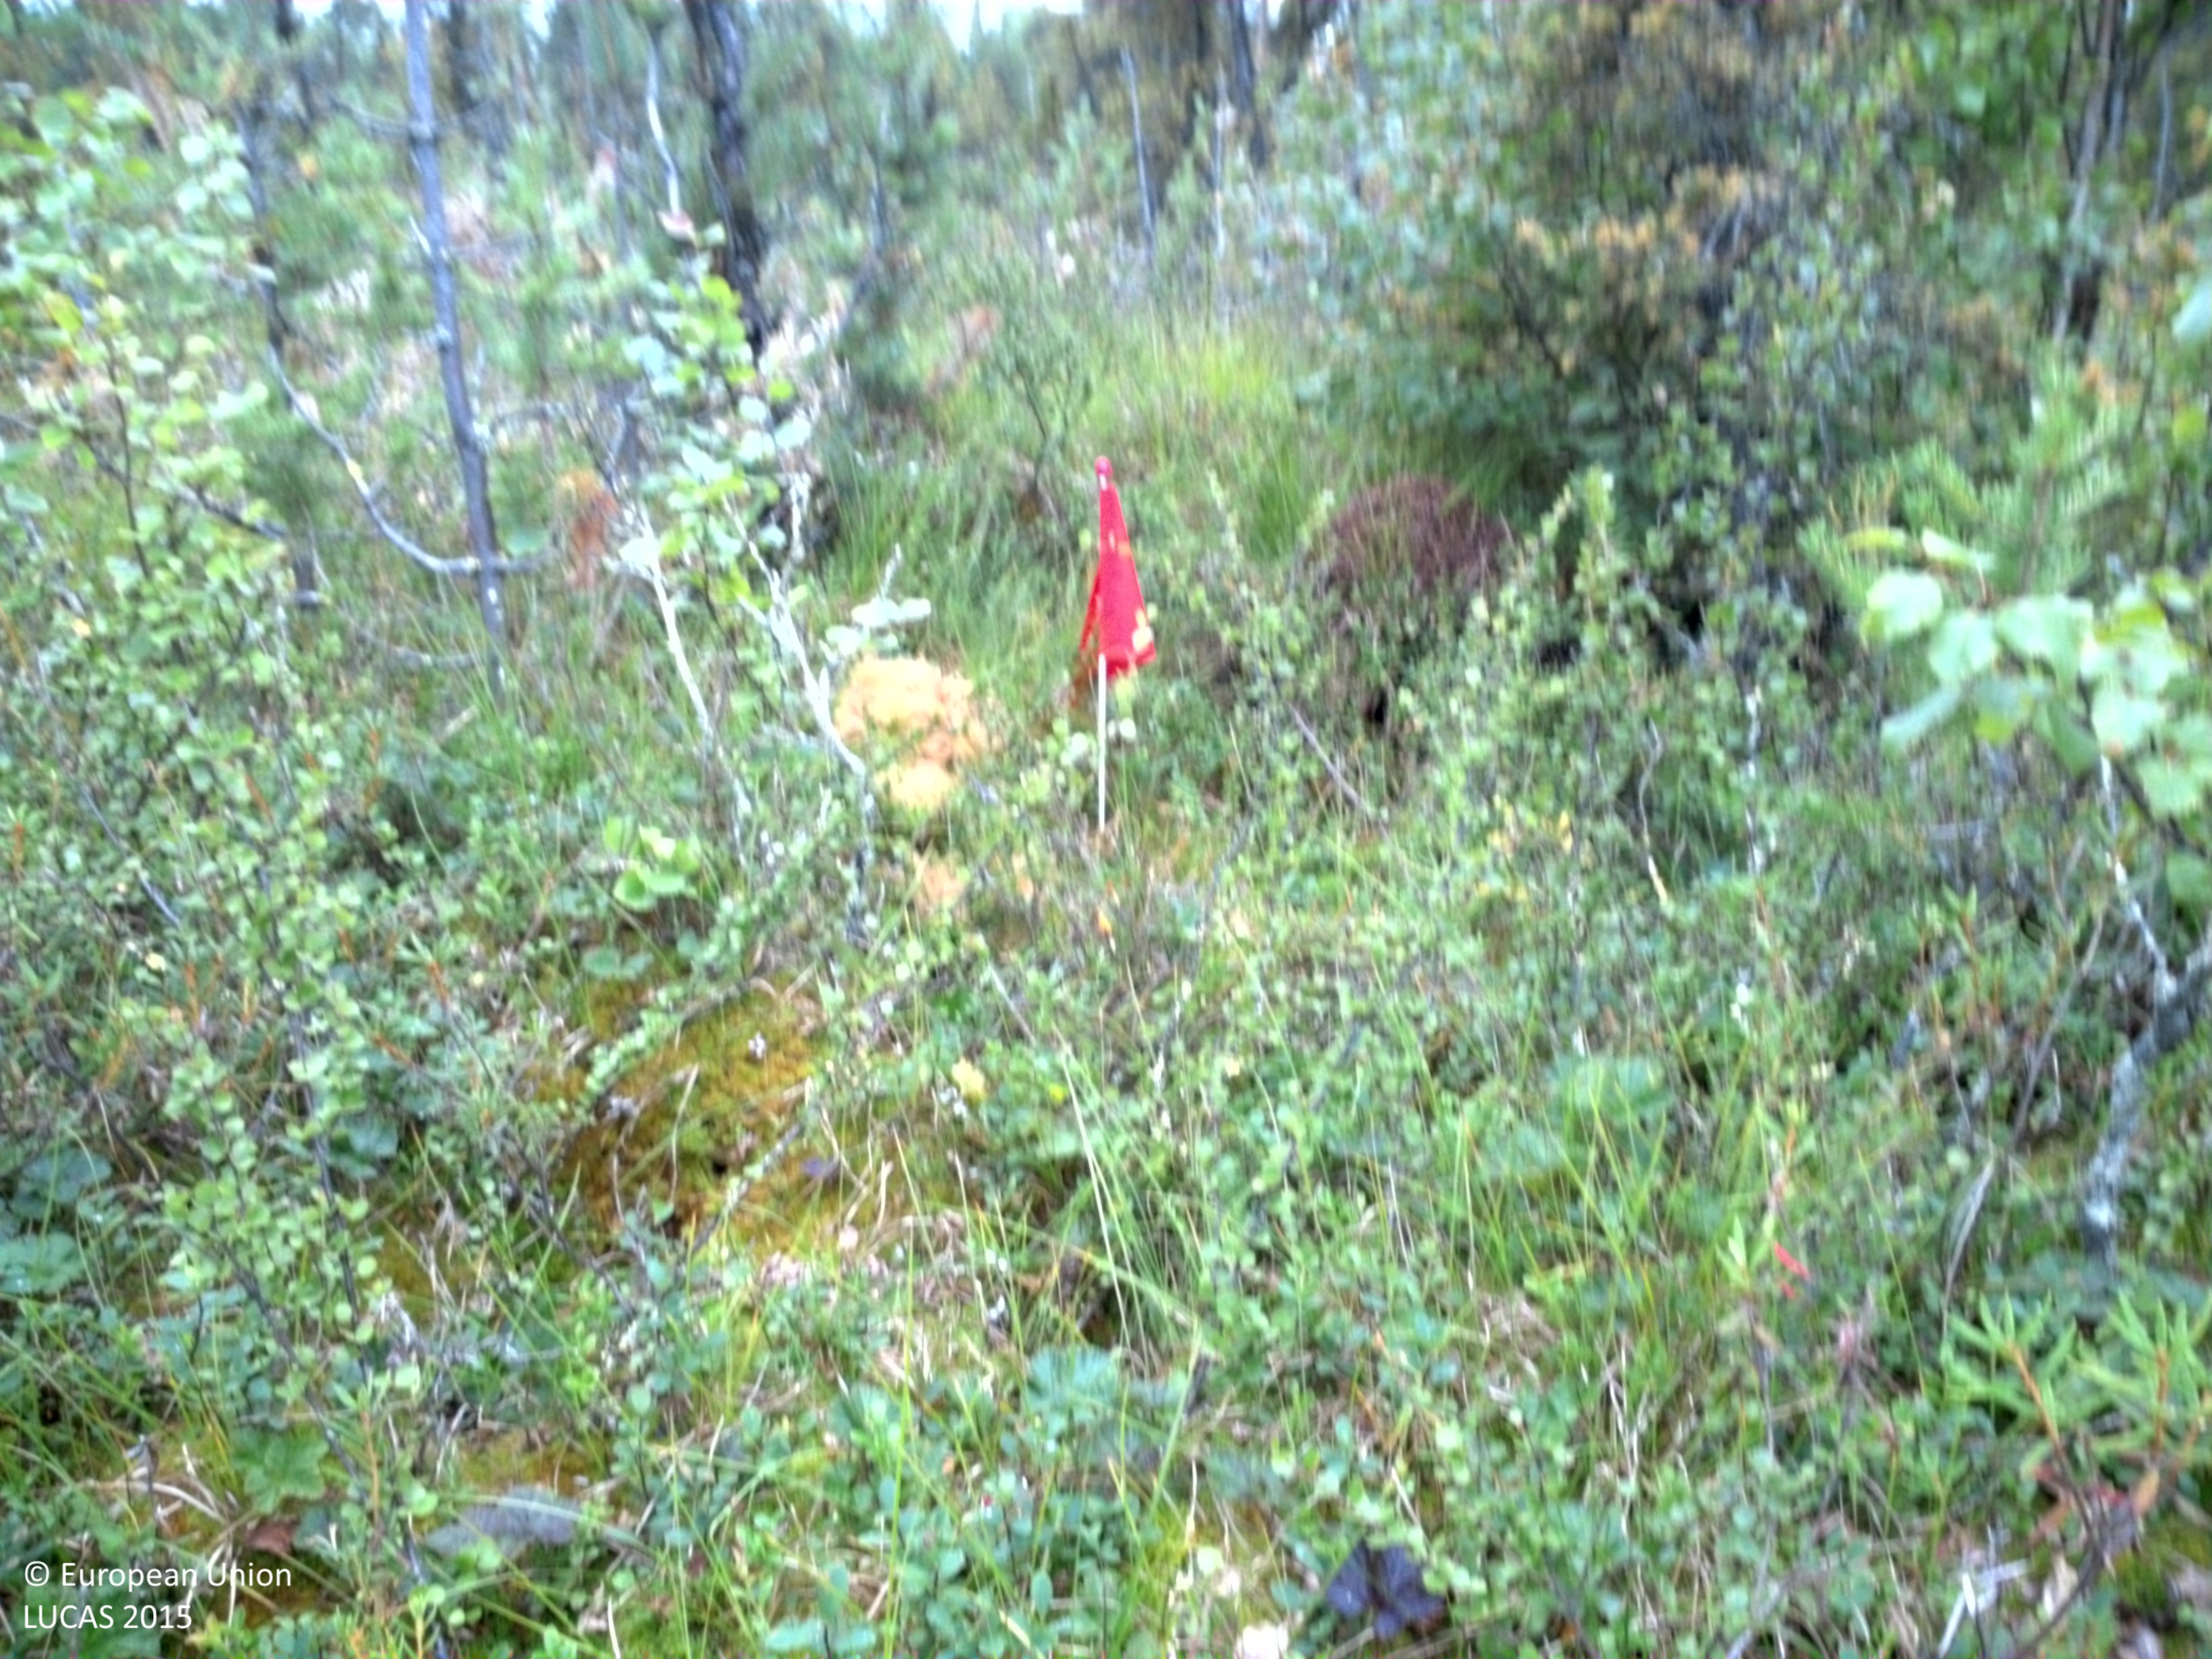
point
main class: Woodland
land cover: Spruce dominated coniferous woodland
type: boreal forest
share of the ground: 25 - 50 %
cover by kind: shrubs 75 %, coniferous forest trees 25 %
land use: Semi-natural and natural areas not in use
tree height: > 5 m
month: August
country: SE
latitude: 66.4742
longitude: 20.5761
